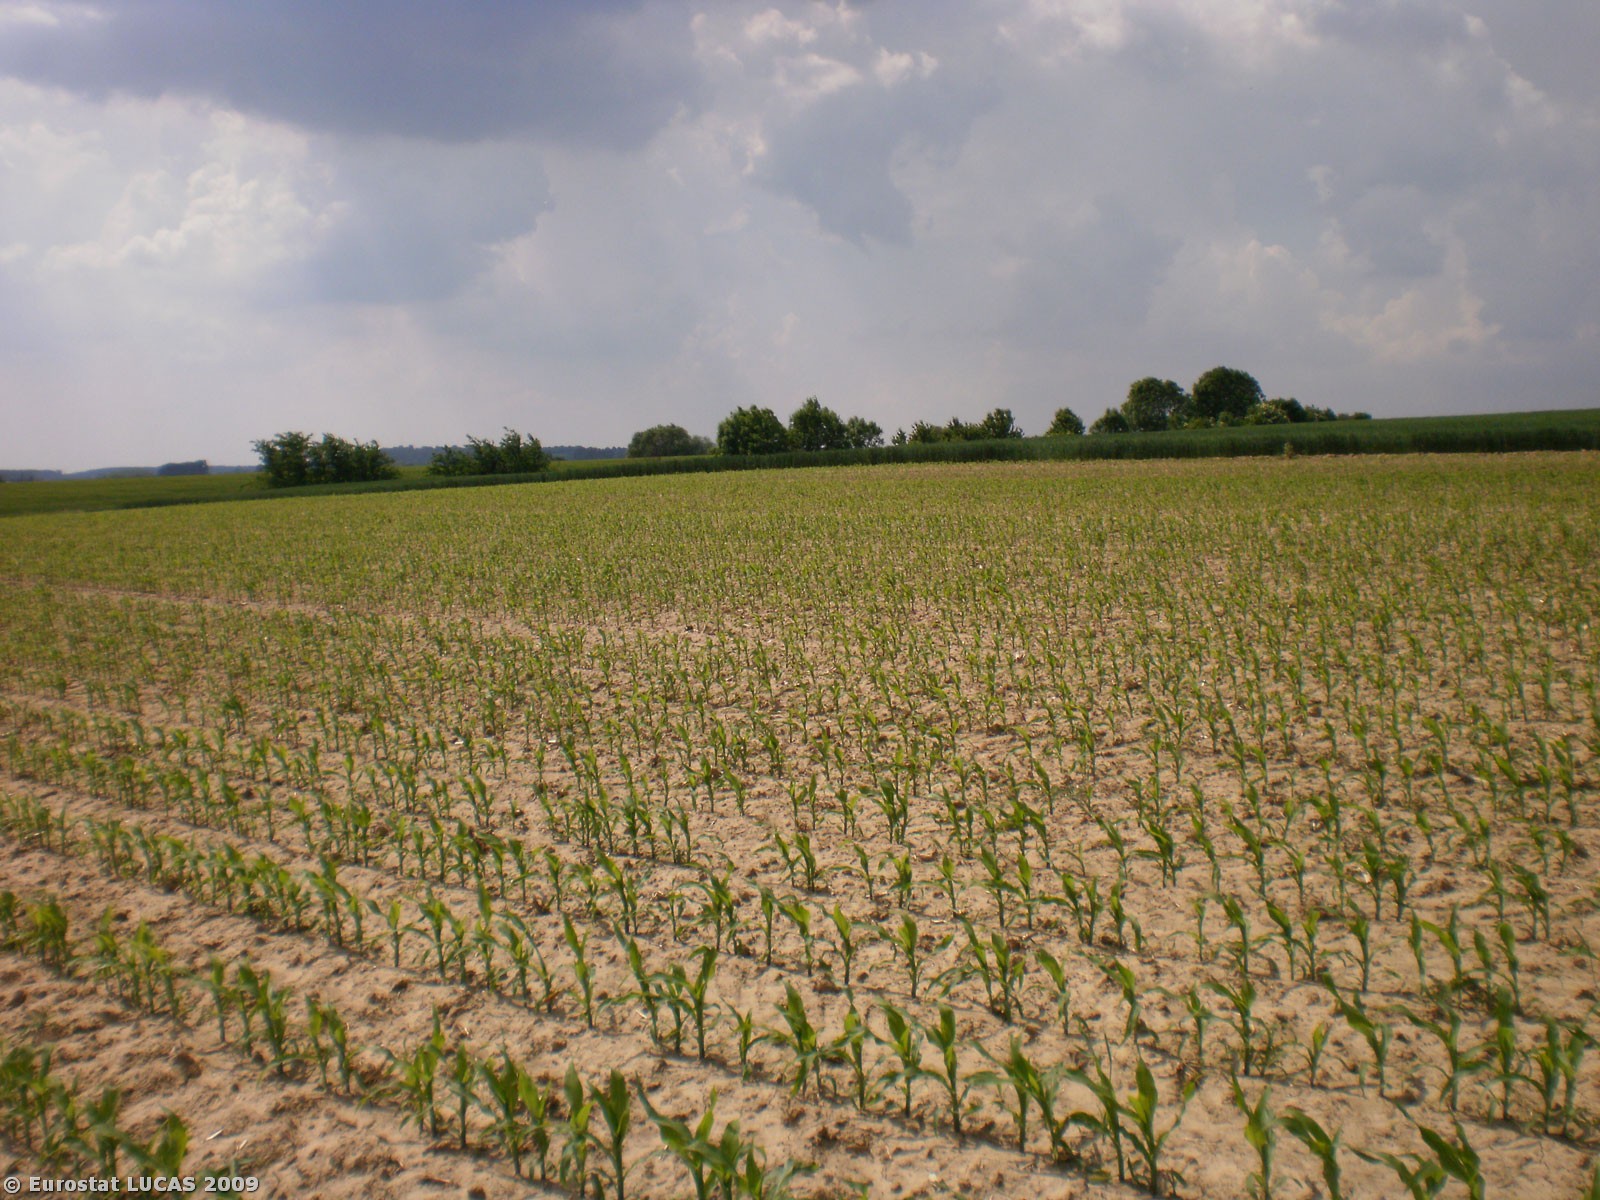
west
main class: Cropland
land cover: Maize
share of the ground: 10 - 25 %
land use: Agriculture (excluding fallow land and kitchen gardens)
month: June
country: BE
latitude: 50.6623
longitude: 3.7544
